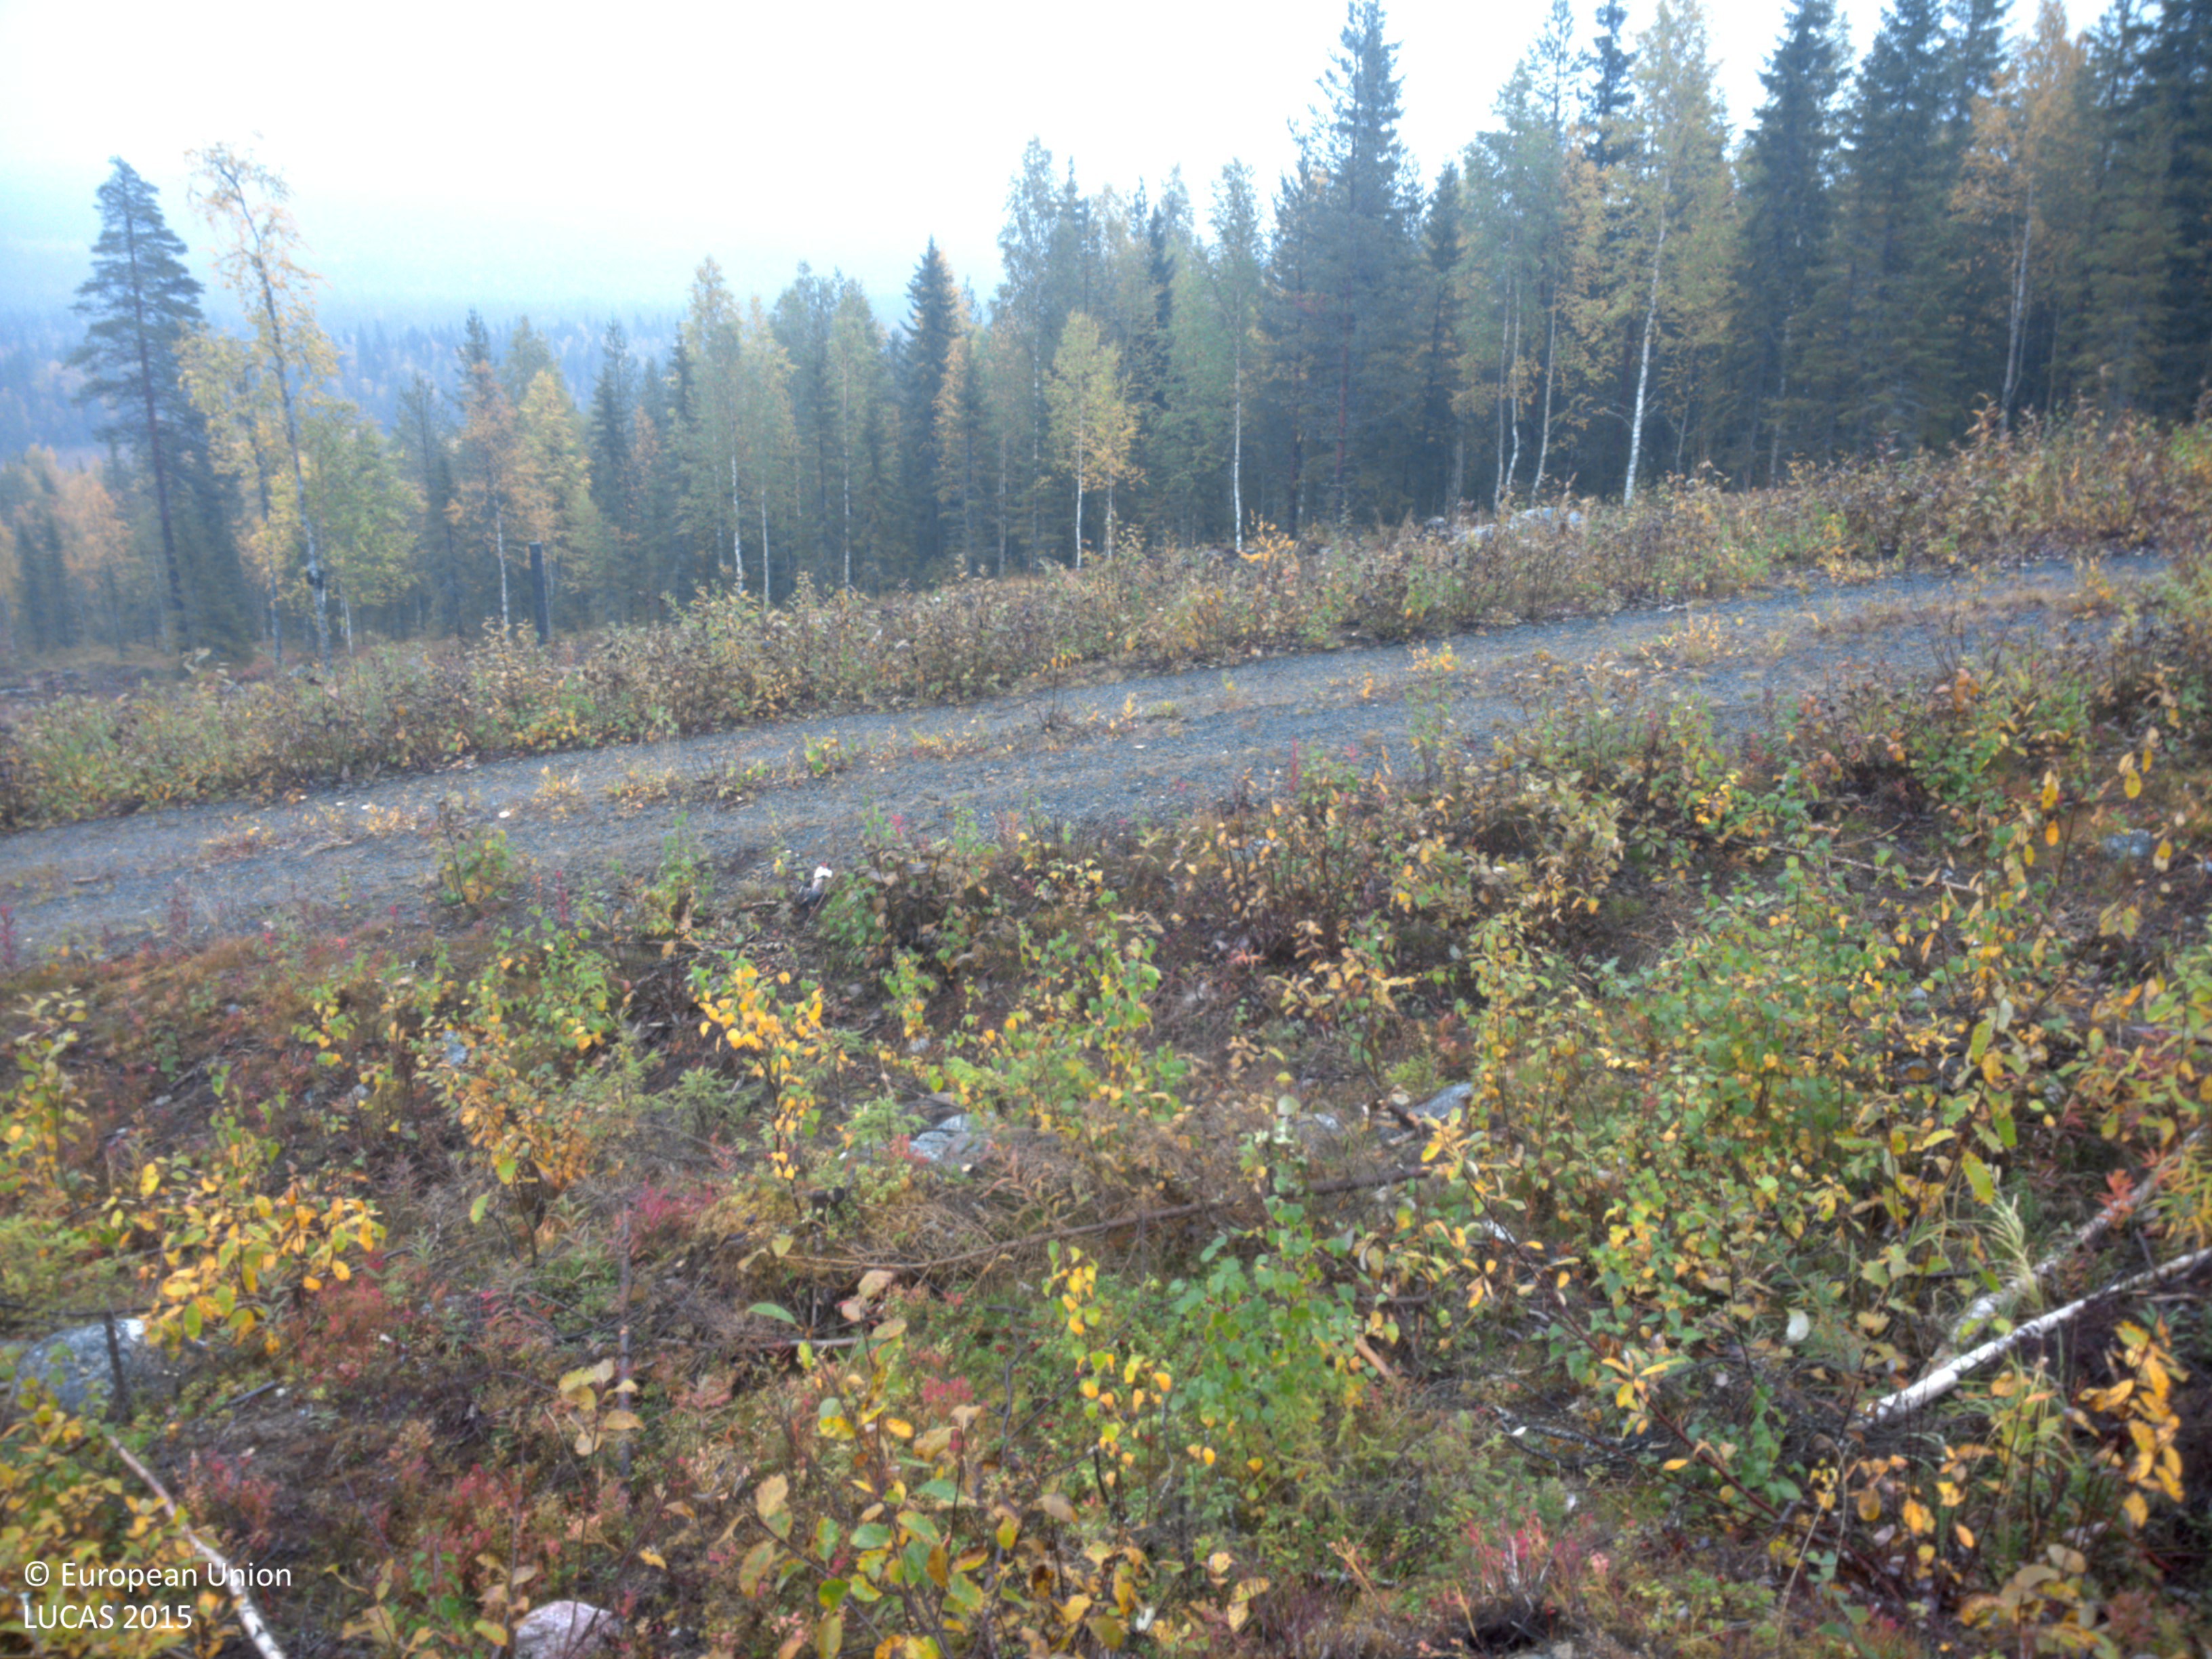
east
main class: Shrubland
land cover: Shrubland with sparse tree cover
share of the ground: 50 - 75 %
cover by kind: shrubs 65 %, unconsolidated bare surface 25 %, coniferous forest trees 5 %, consolidated bare surface 5 %
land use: Forestry
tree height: < 5 m
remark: Clear cut
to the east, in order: Shrubland with sparse tree cover; Ditches and canals; Tracks; Ditches and canals; Shrubland with sparse tree cover; Spruce dominated mixed woodland; Pine dominated mixed woodland
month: September
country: SE
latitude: 64.8932
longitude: 19.2398
